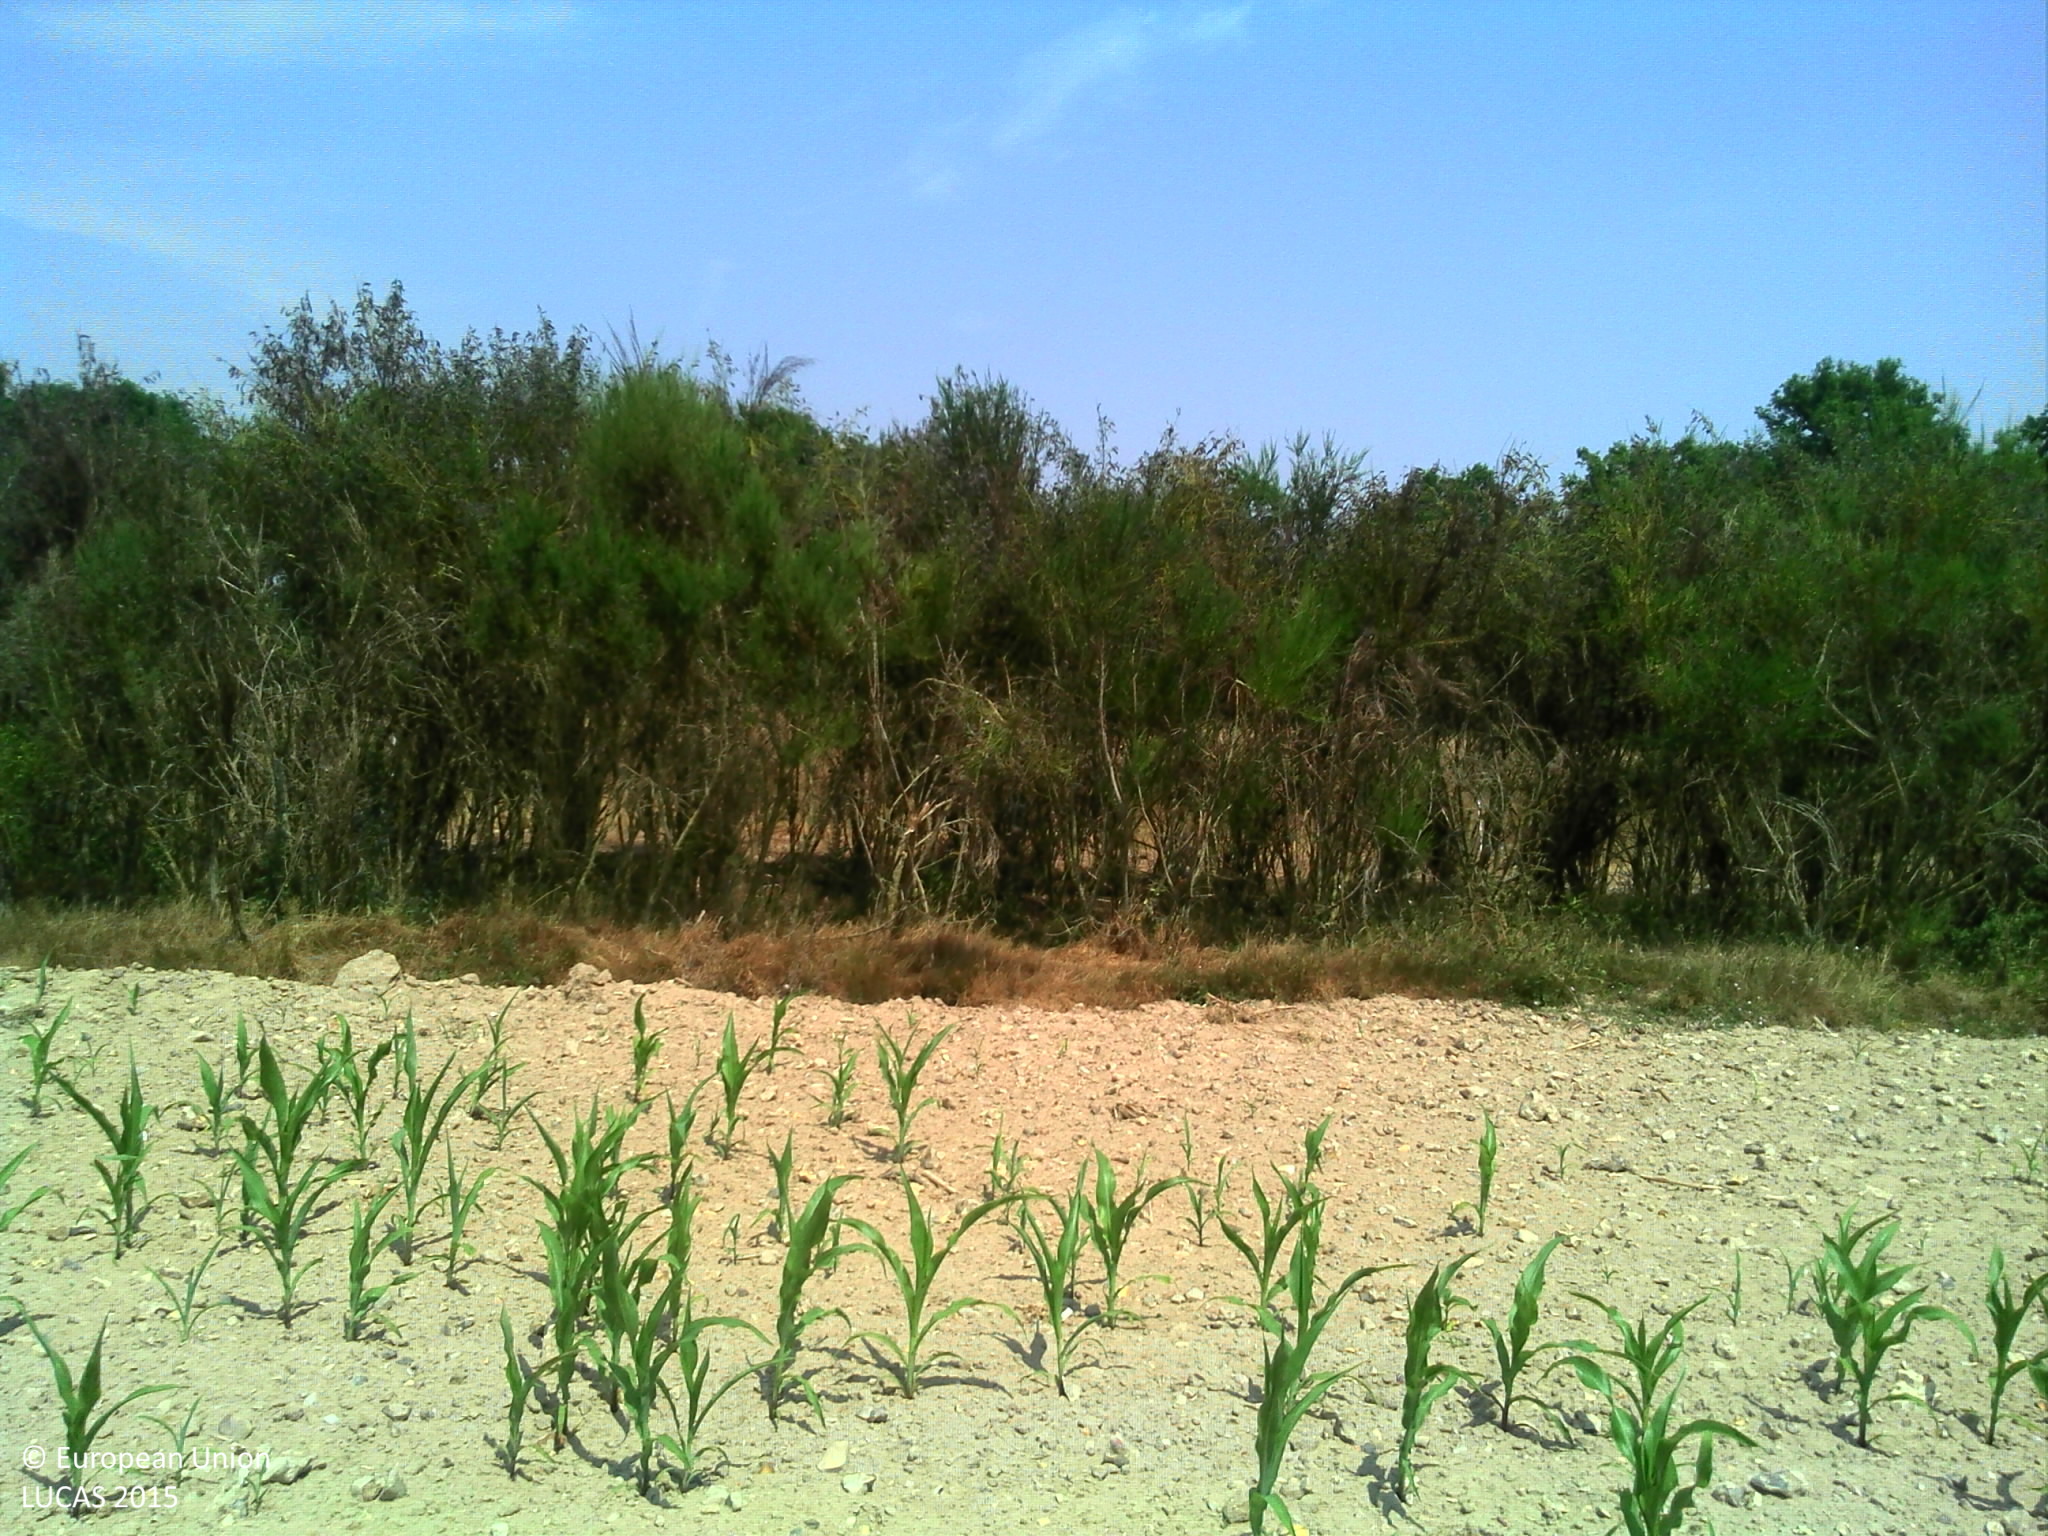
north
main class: Cropland
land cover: Maize
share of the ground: 10 - 25 %
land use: Agriculture (excluding fallow land and kitchen gardens)
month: July
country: FR
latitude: 47.7909
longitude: 2.8243
